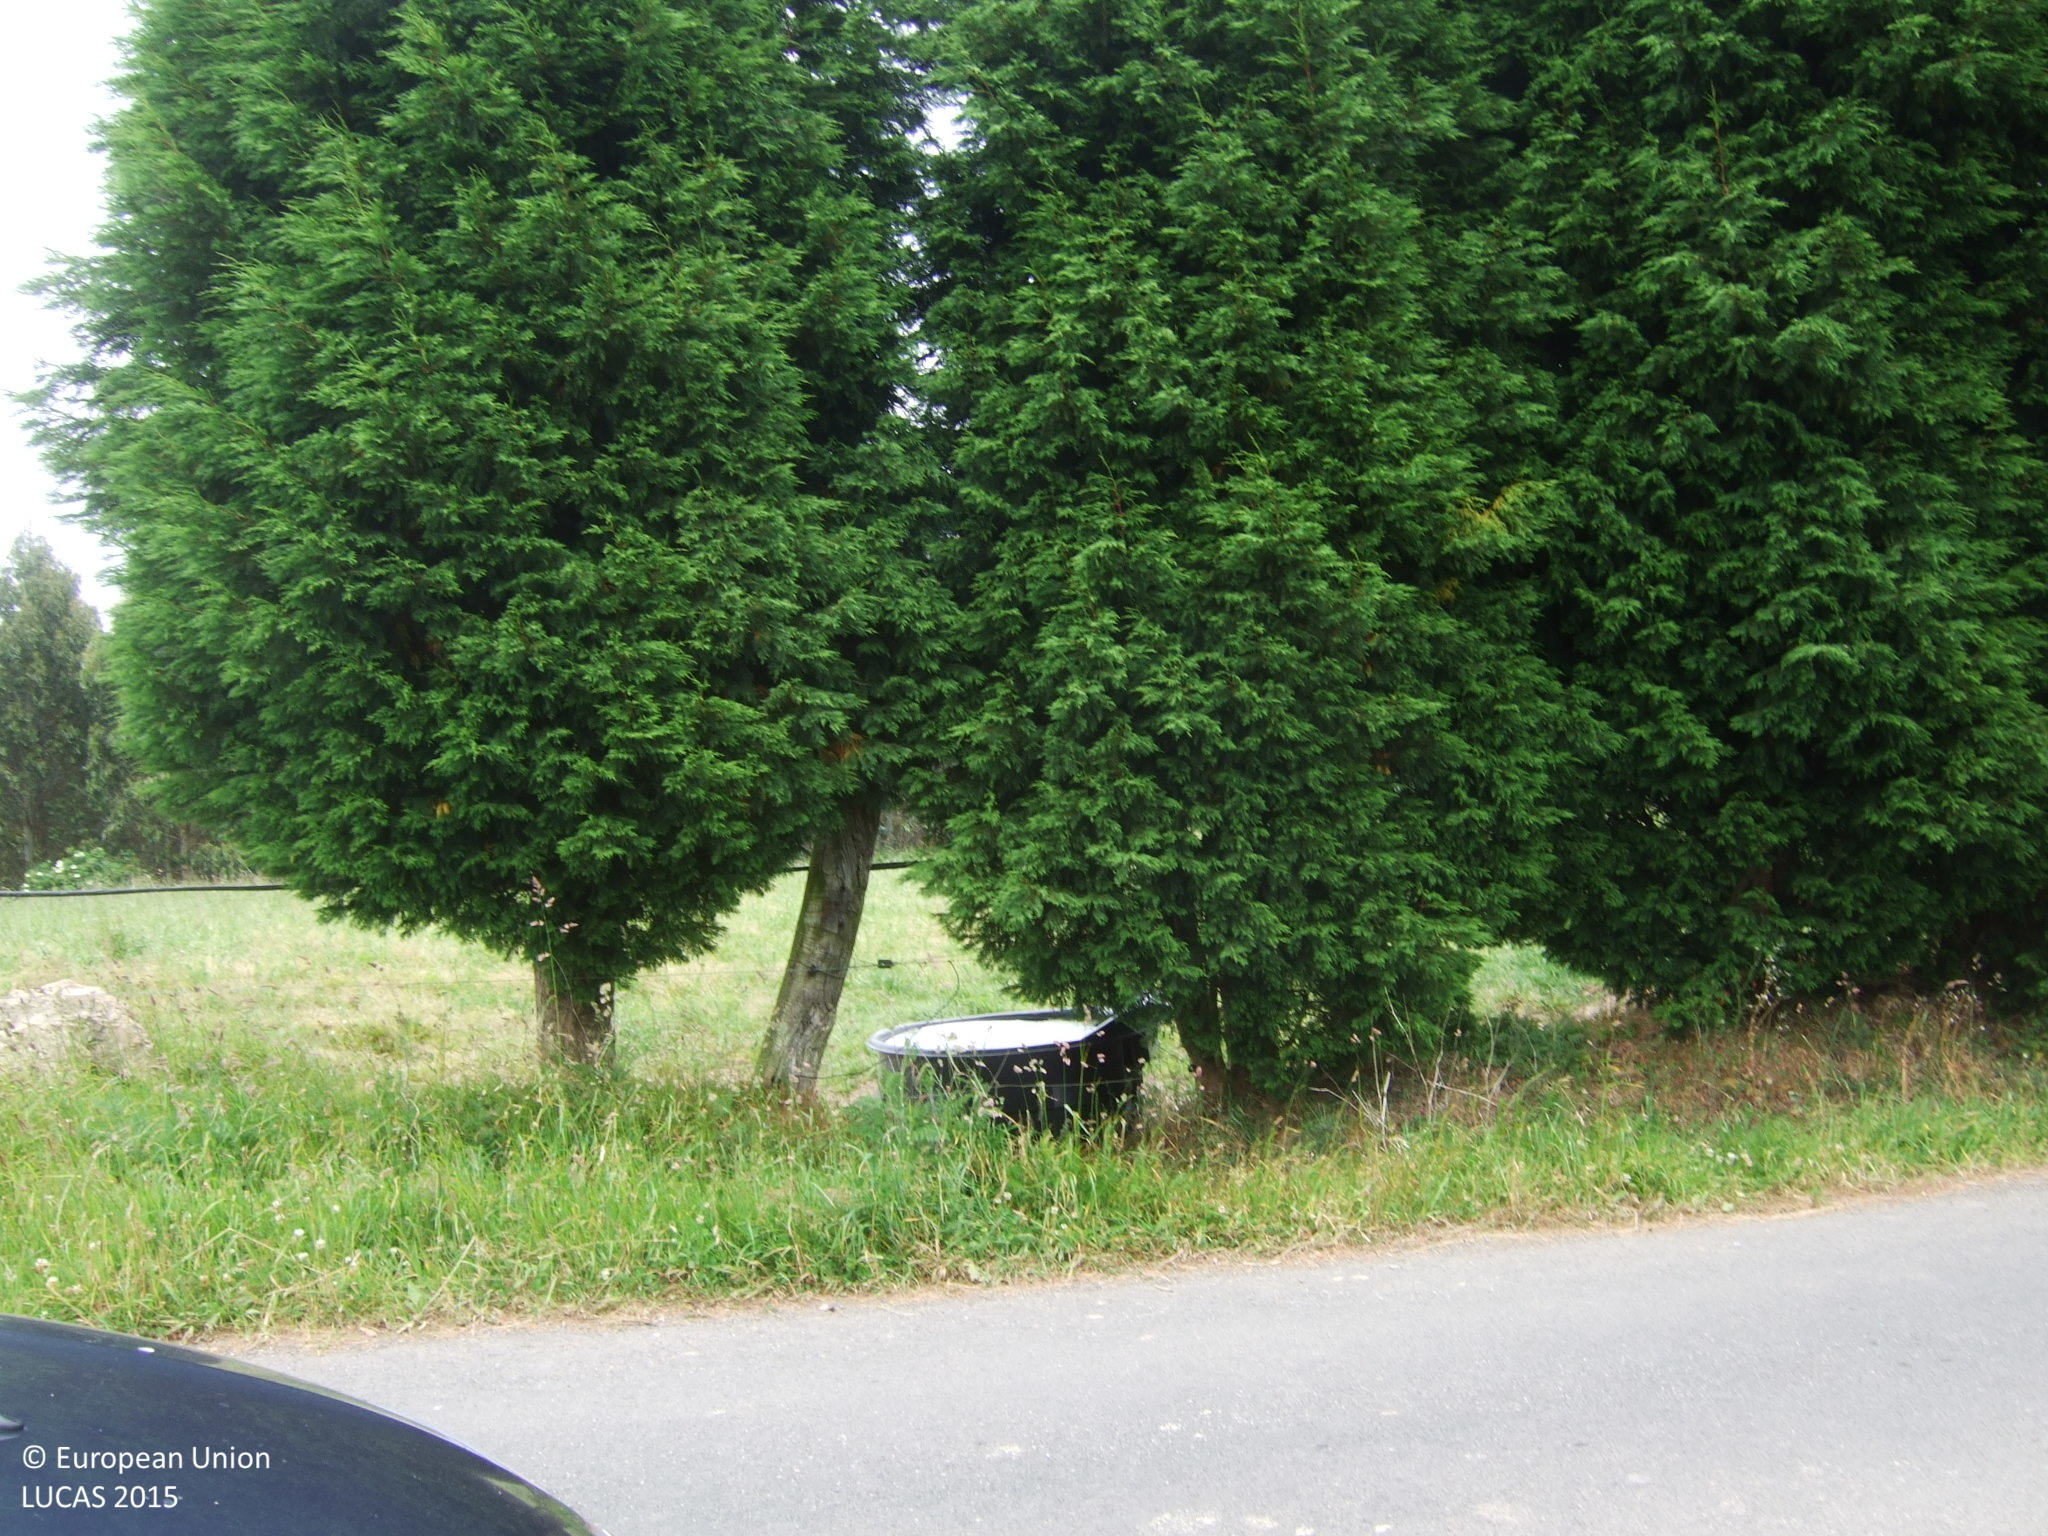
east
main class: Grassland
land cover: Grassland without tree/shrub cover
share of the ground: > 75 %
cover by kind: herbaceous plants 100 %
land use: Agriculture (excluding fallow land and kitchen gardens)
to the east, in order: Grassland without tree/shrub cover; Fences; Paved roads, cycling and walking lanes; Managed hedges; Fences; Grassland without tree/shrub cover; Broadleaved woodland; Shrubland without tree cover
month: June
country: ES
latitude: 43.5997
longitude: -7.8445
